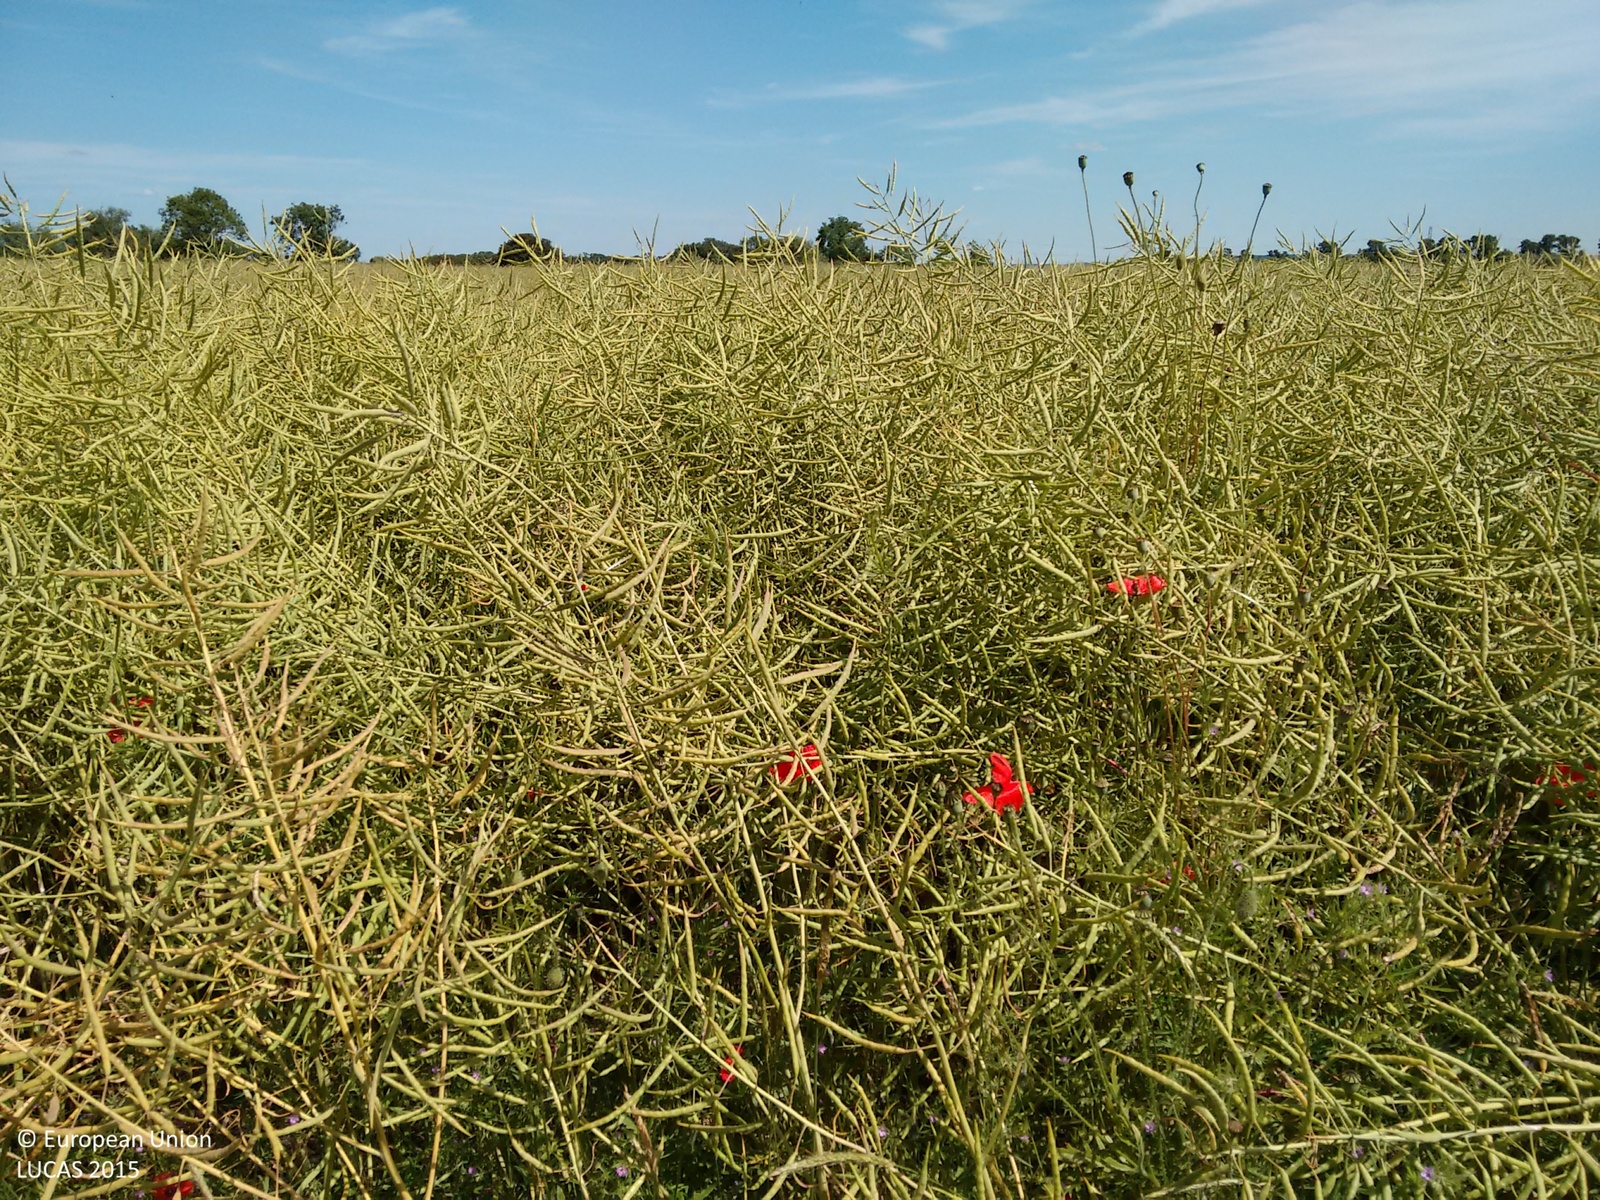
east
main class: Cropland
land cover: Rape and turnip rape
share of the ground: > 75 %
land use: Agriculture (excluding fallow land and kitchen gardens)
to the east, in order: Rape and turnip rape; Managed hedges; Grass margins; Rape and turnip rape
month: July
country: GB
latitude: 52.8991
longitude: -1.0001
